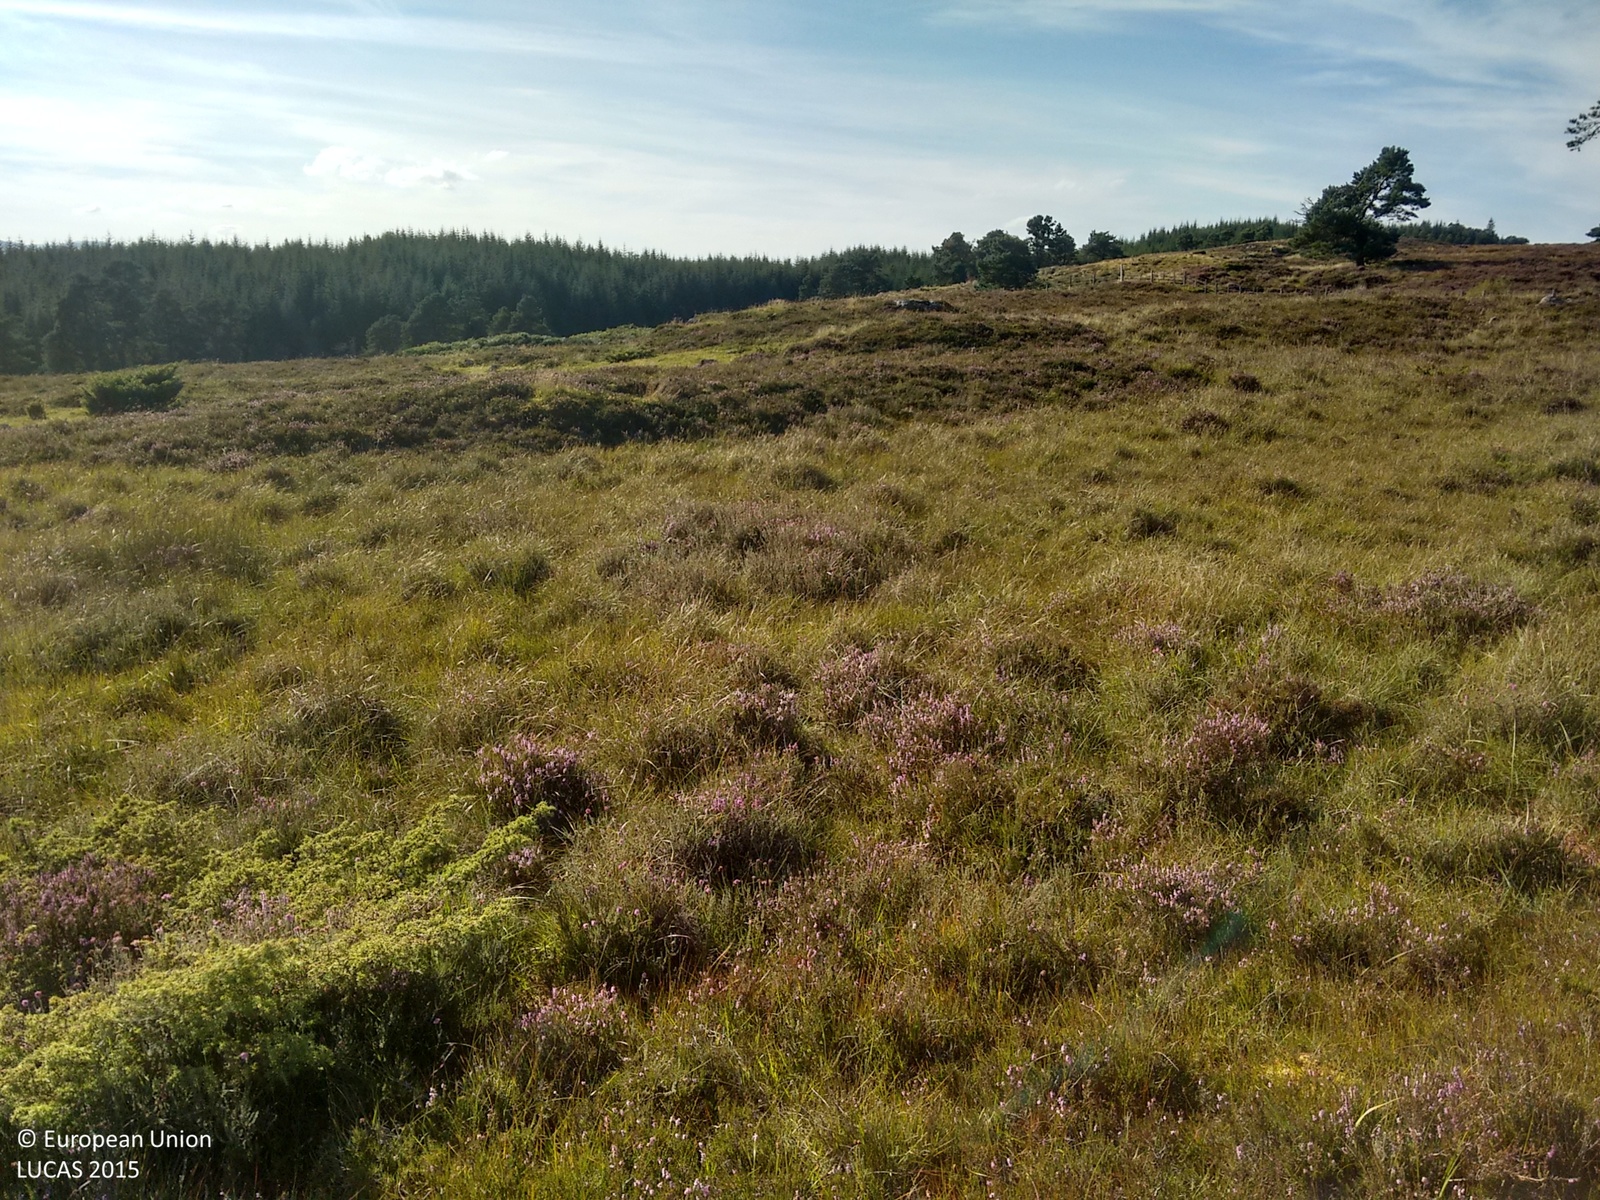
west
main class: Shrubland
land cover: Shrubland without tree cover
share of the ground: > 75 %
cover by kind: shrubs 100 %
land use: Agriculture (excluding fallow land and kitchen gardens)
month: September
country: GB
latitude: 57.9199
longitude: -4.3503
